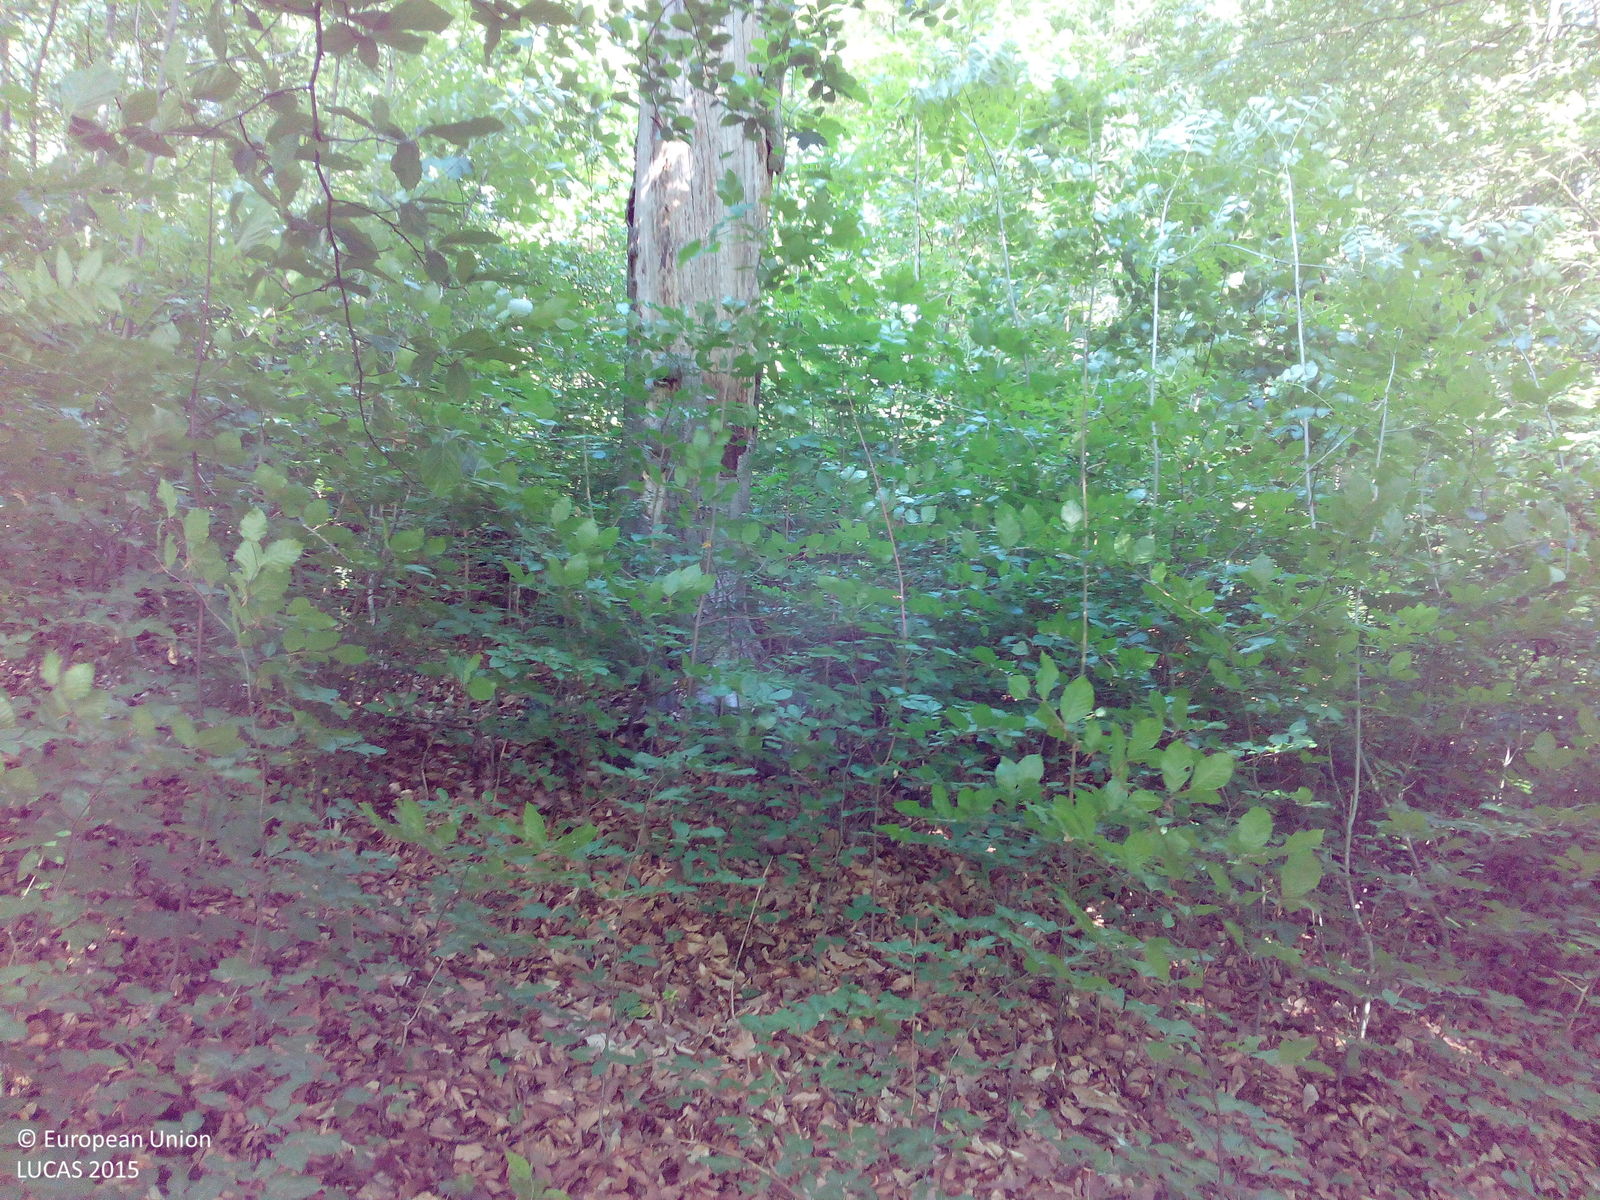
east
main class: Woodland
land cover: Broadleaved woodland
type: beech forest
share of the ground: > 75 %
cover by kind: broadleaved forest trees 85 %, unconsolidated bare surface 10 %, shrubs 5 %
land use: Forestry
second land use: Amenities, museums, leisure
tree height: > 5 m
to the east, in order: Broadleaved woodland; Grassland without tree/shrub cover; Tracks; Grassland without tree/shrub cover
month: June
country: DE
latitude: 50.7863
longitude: 11.4606
